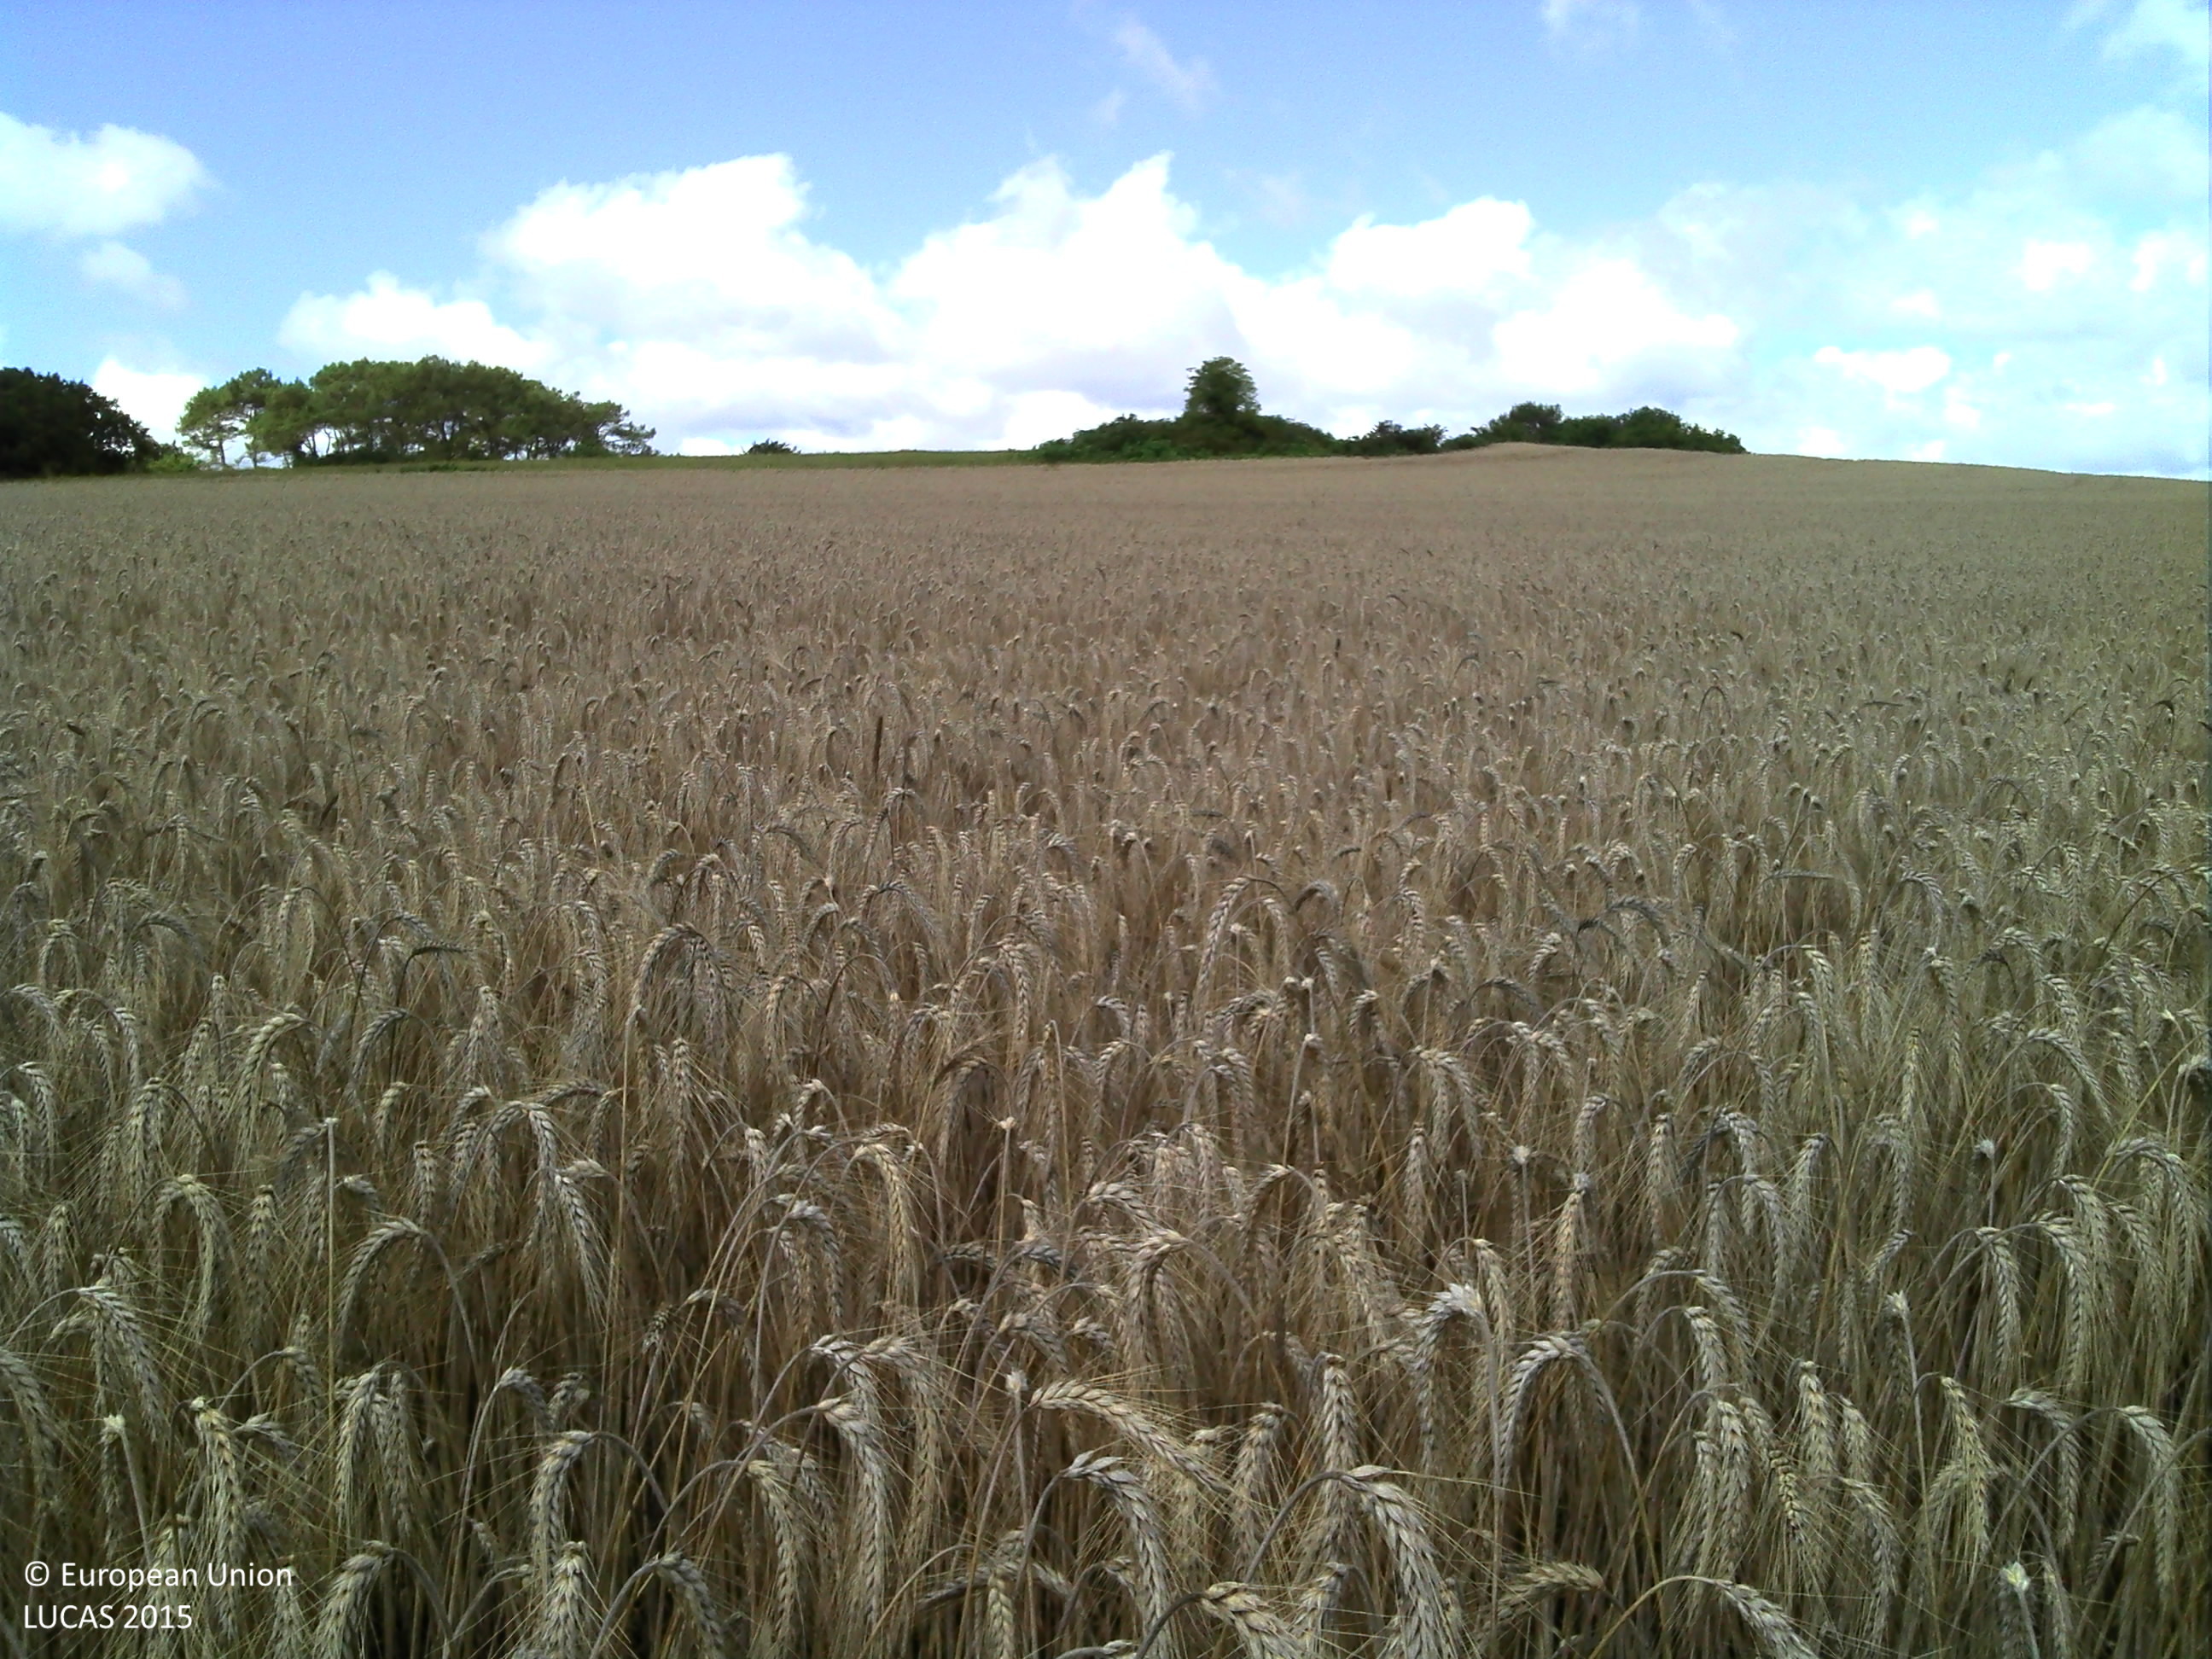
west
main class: Cropland
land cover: Common wheat
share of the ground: > 75 %
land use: Agriculture (excluding fallow land and kitchen gardens)
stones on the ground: < 10 %
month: July
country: FR
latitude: 47.7521
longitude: -2.9104
